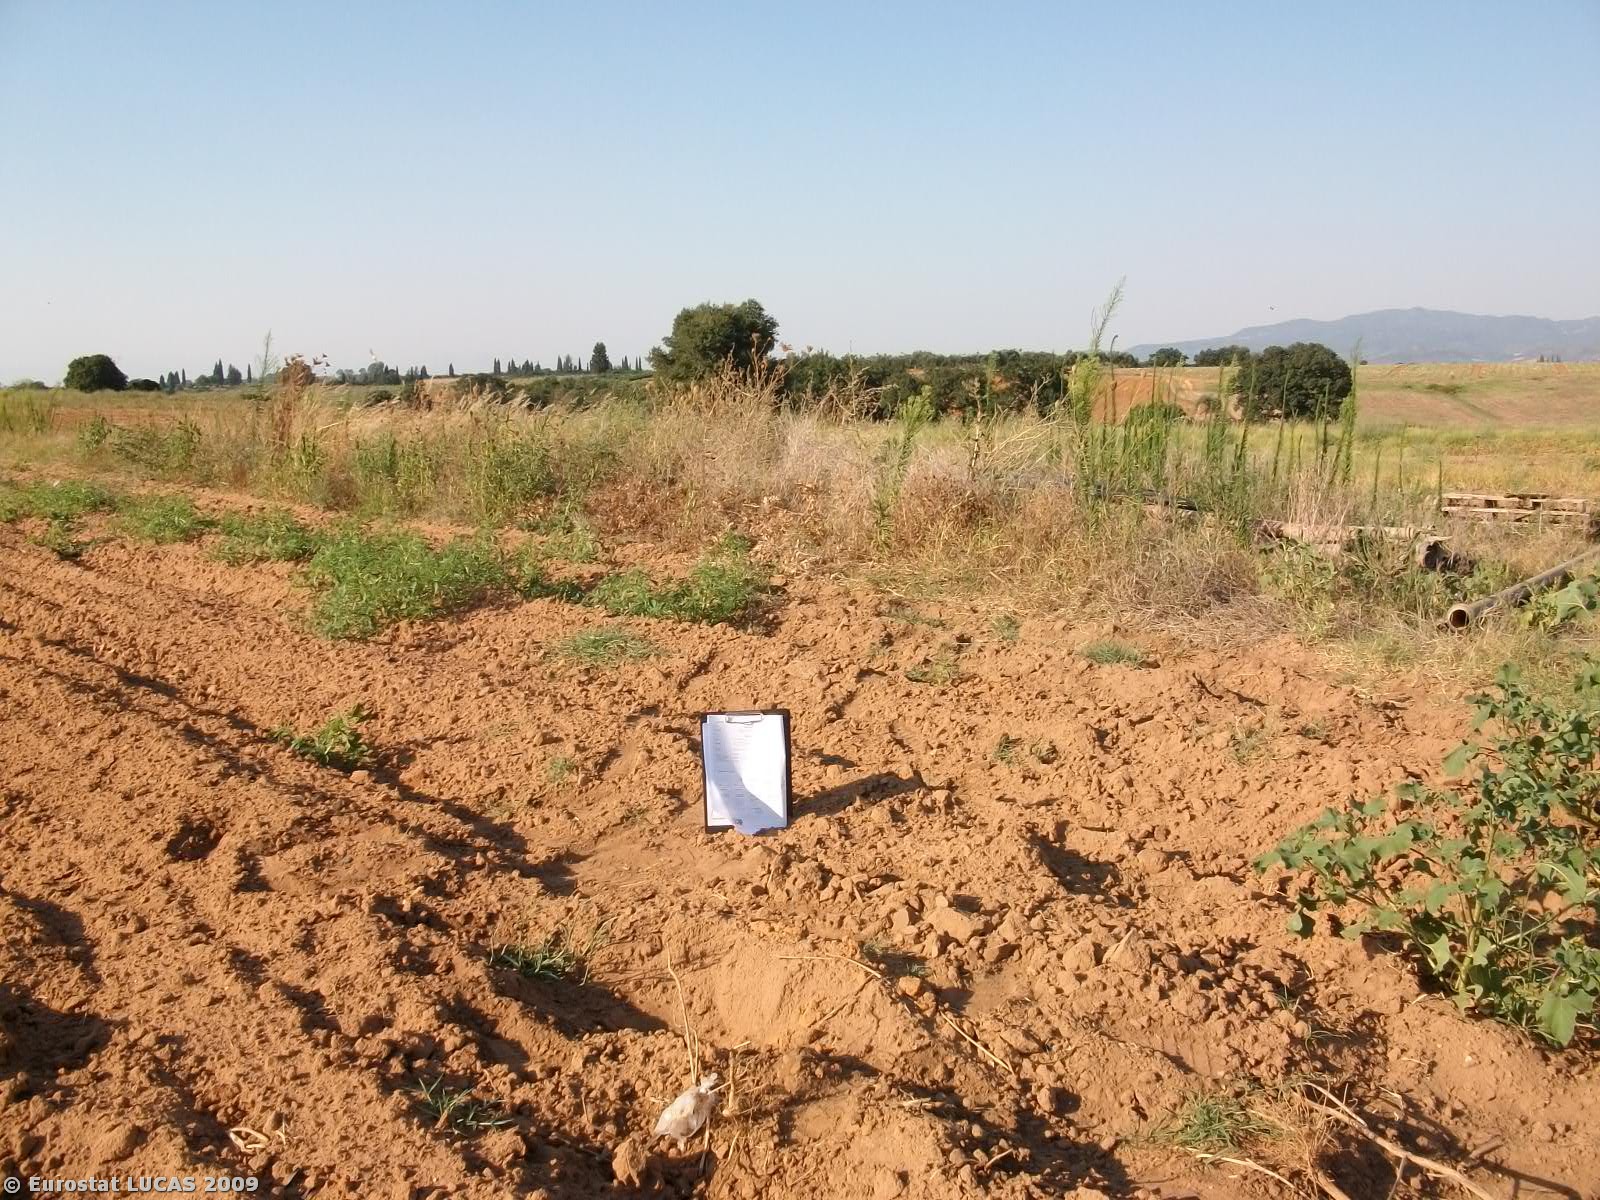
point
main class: Cropland
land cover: Other fresh vegetables
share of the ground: 10 - 25 %
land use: Agriculture (excluding fallow land and kitchen gardens)
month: July
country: GR
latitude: 37.9767
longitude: 21.3806
